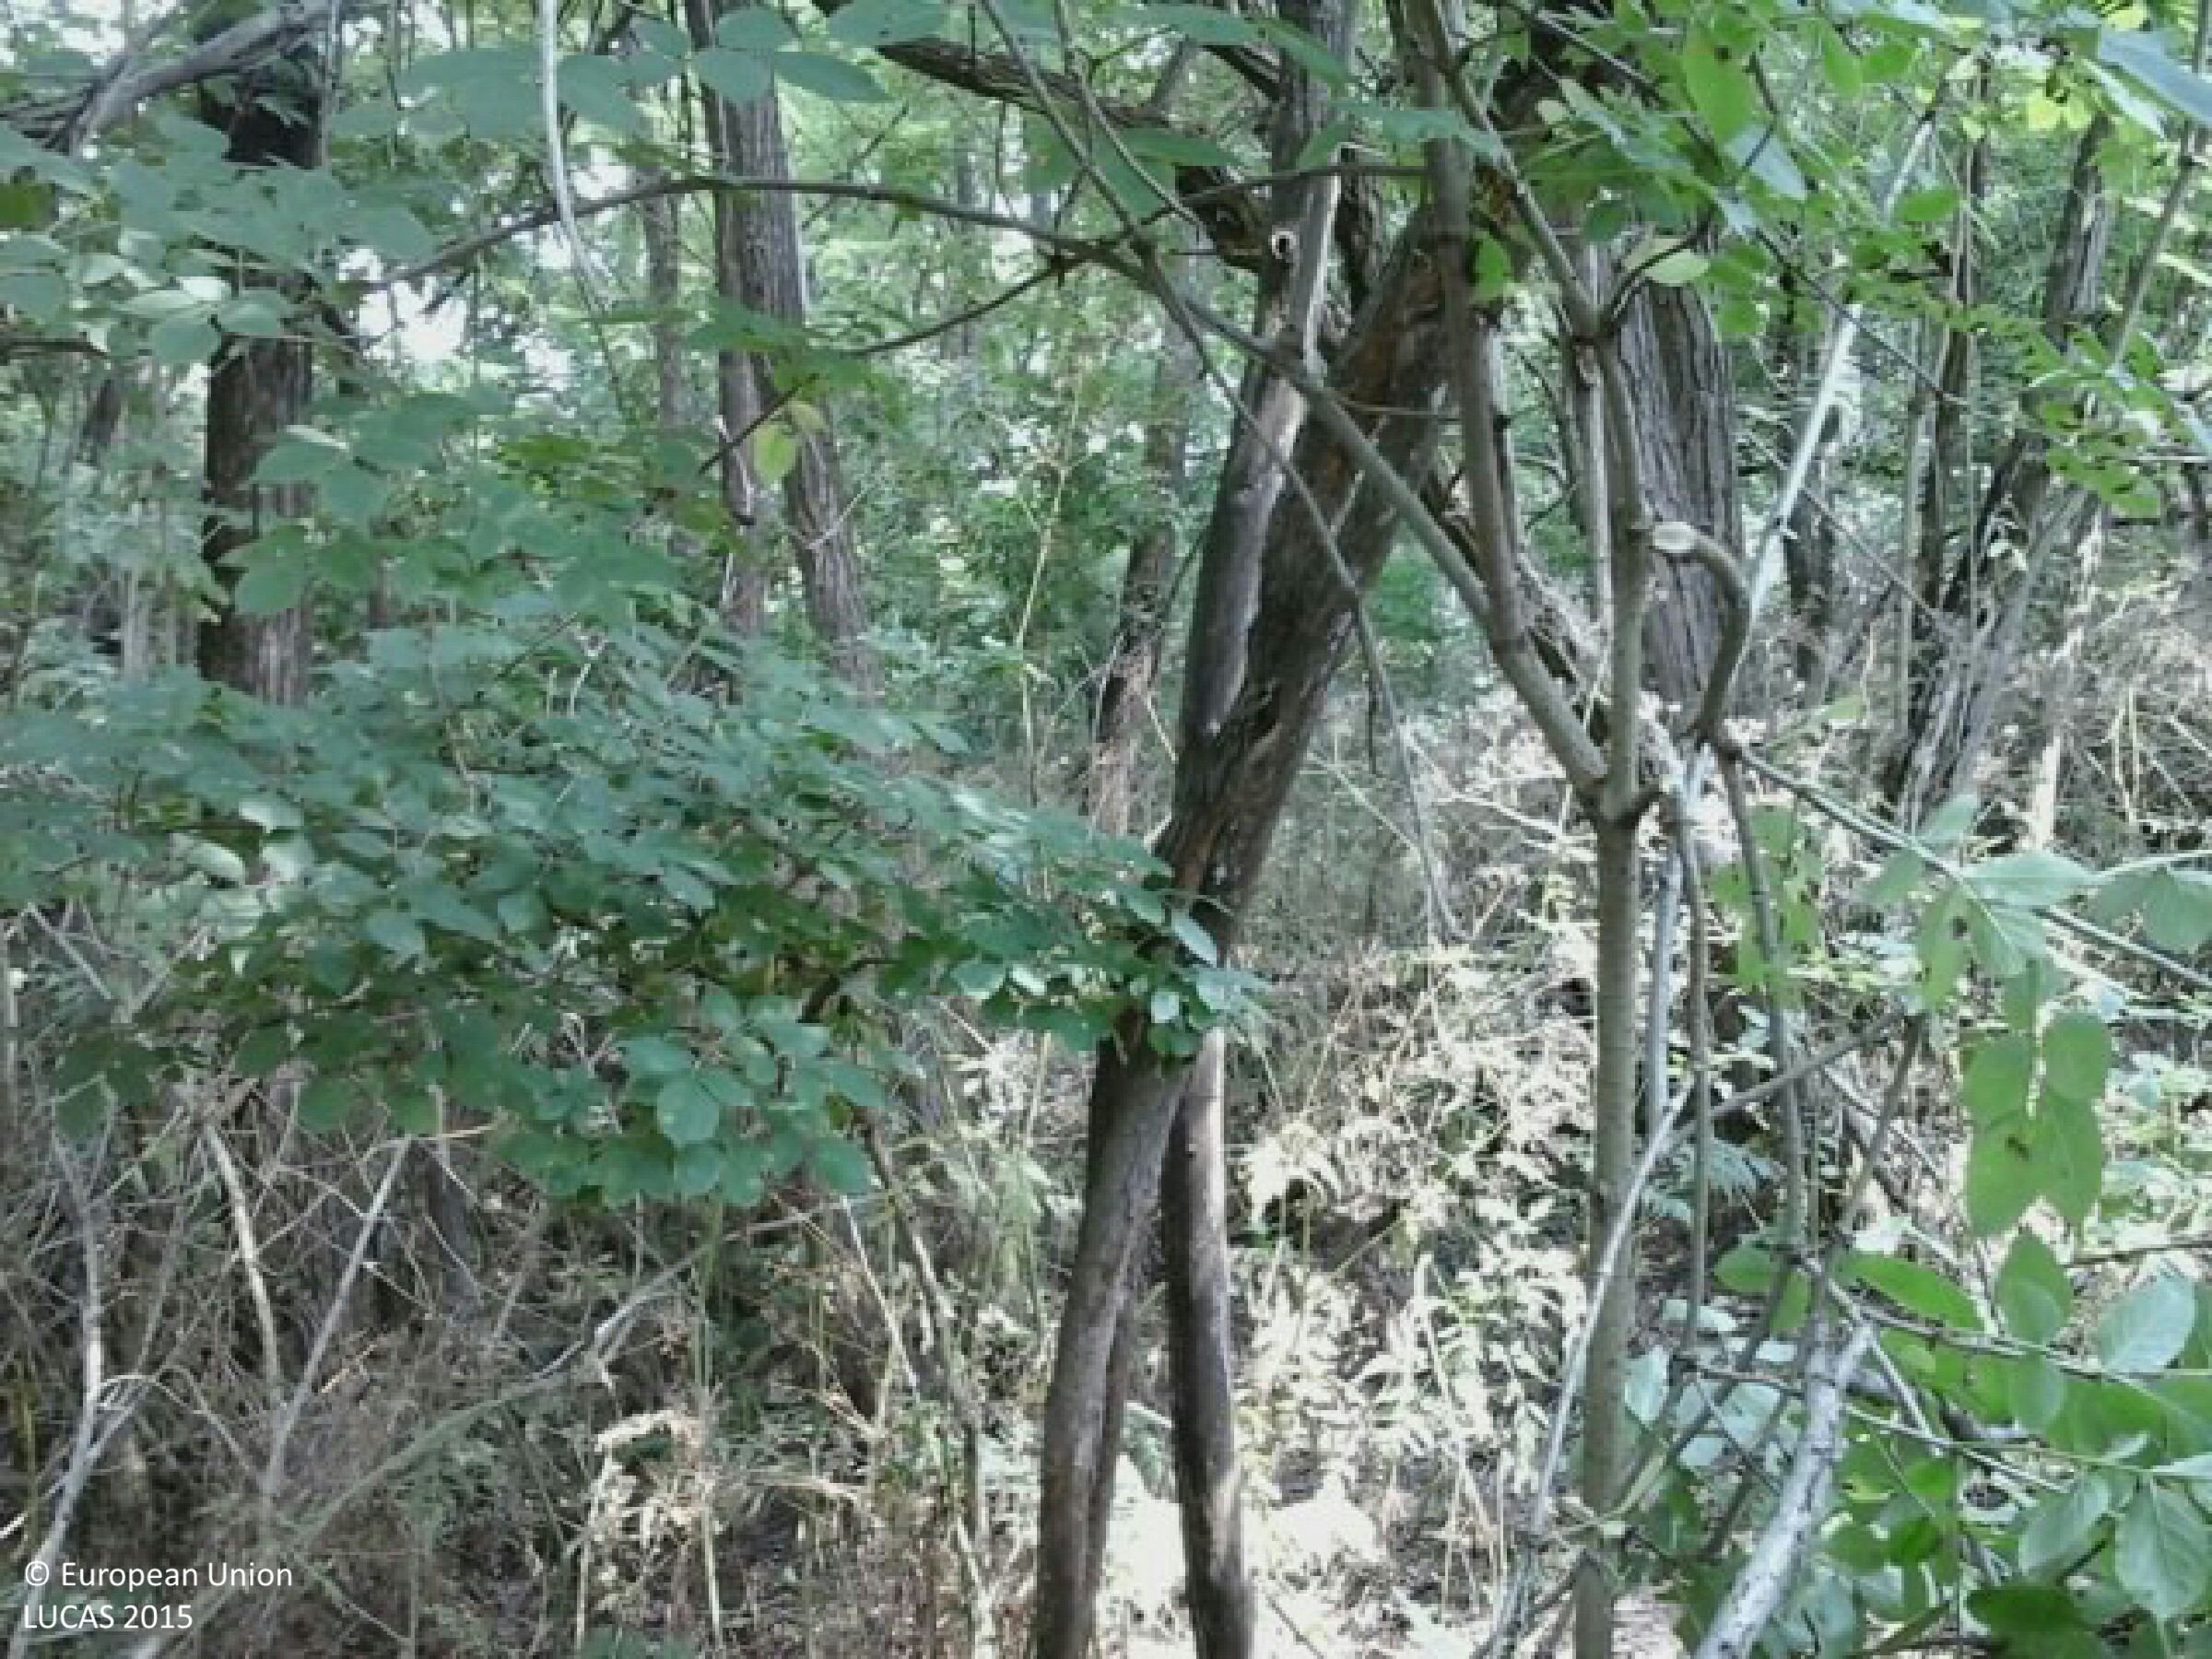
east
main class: Woodland
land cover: Broadleaved woodland
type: mesophytic deciduous forest
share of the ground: > 75 %
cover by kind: broadleaved forest trees 100 %
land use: Forestry
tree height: > 5 m
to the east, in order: Broadleaved woodland; Ditches and canals; Broadleaved woodland; Other bare soil; Common wheat; Grass margins; Other bare soil
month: July
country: HU
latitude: 47.7712
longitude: 19.3485
